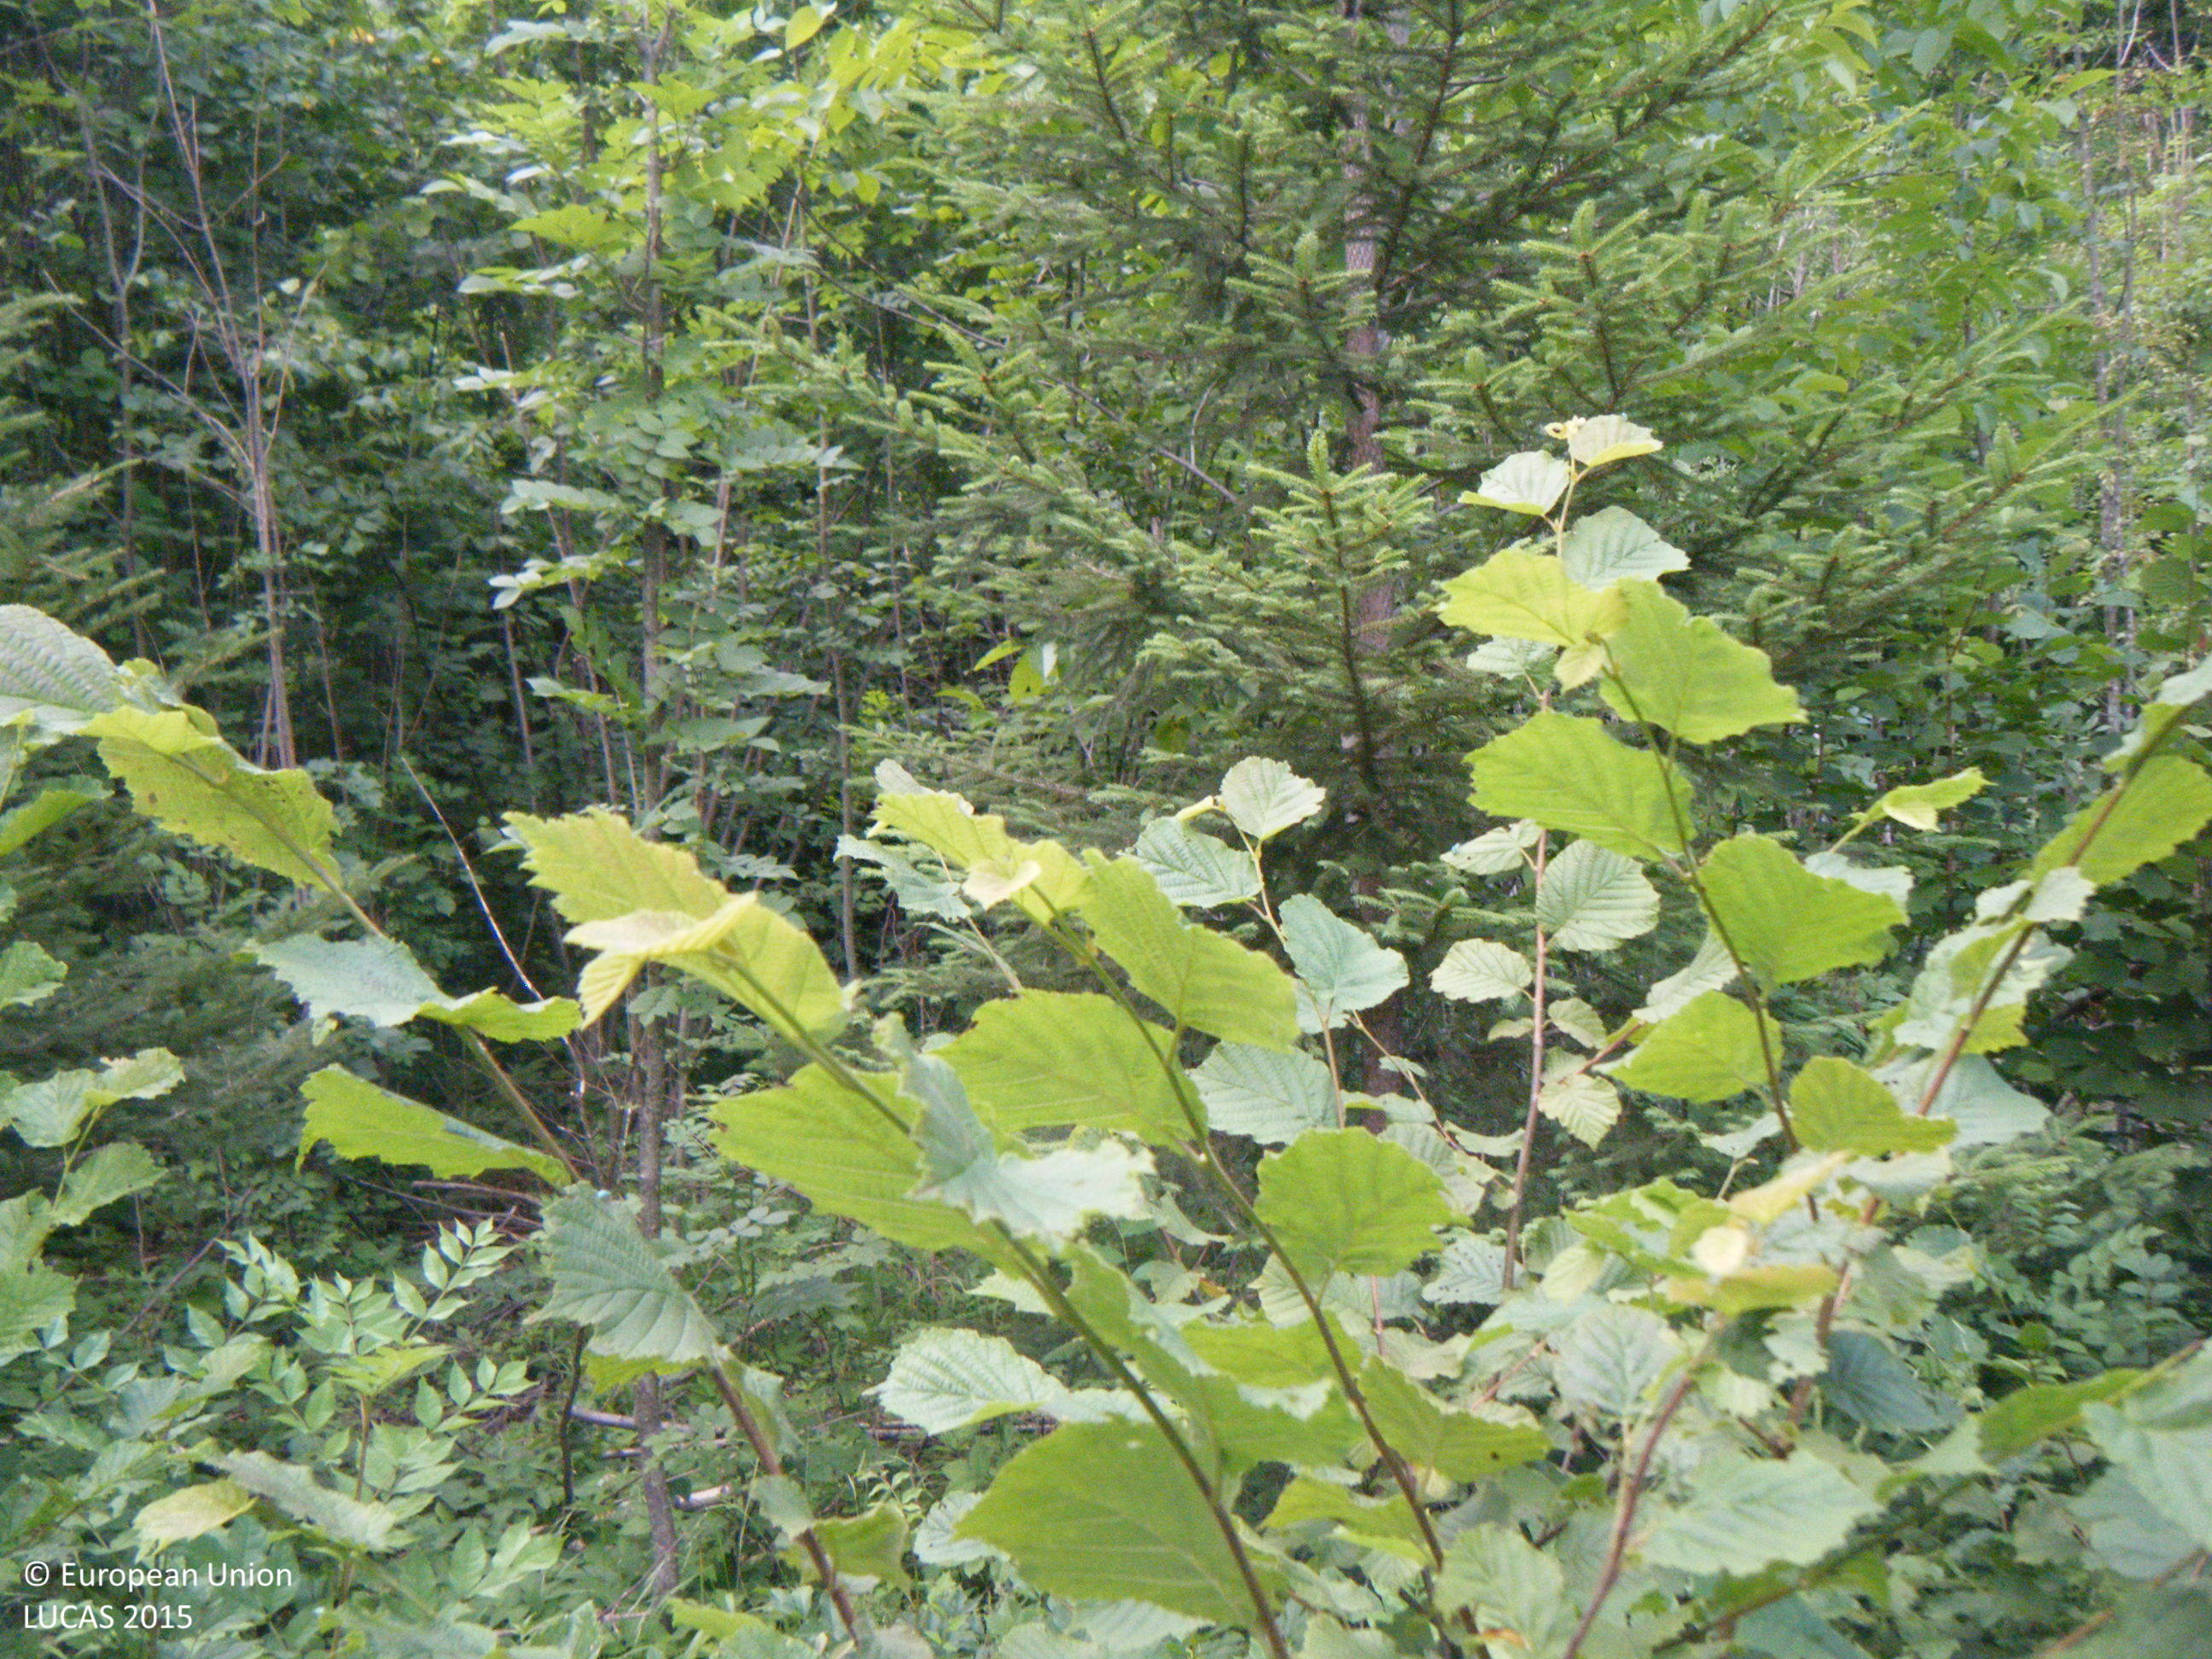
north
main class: Woodland
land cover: Spruce dominated mixed woodland
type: mesophytic deciduous forest
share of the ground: > 75 %
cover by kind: broadleaved forest trees 50 %, coniferous forest trees 25 %, shrubs 15 %, herbaceous plants 10 %
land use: Forestry
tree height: < 5 m
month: July
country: AT
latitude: 47.7347
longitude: 13.5324
